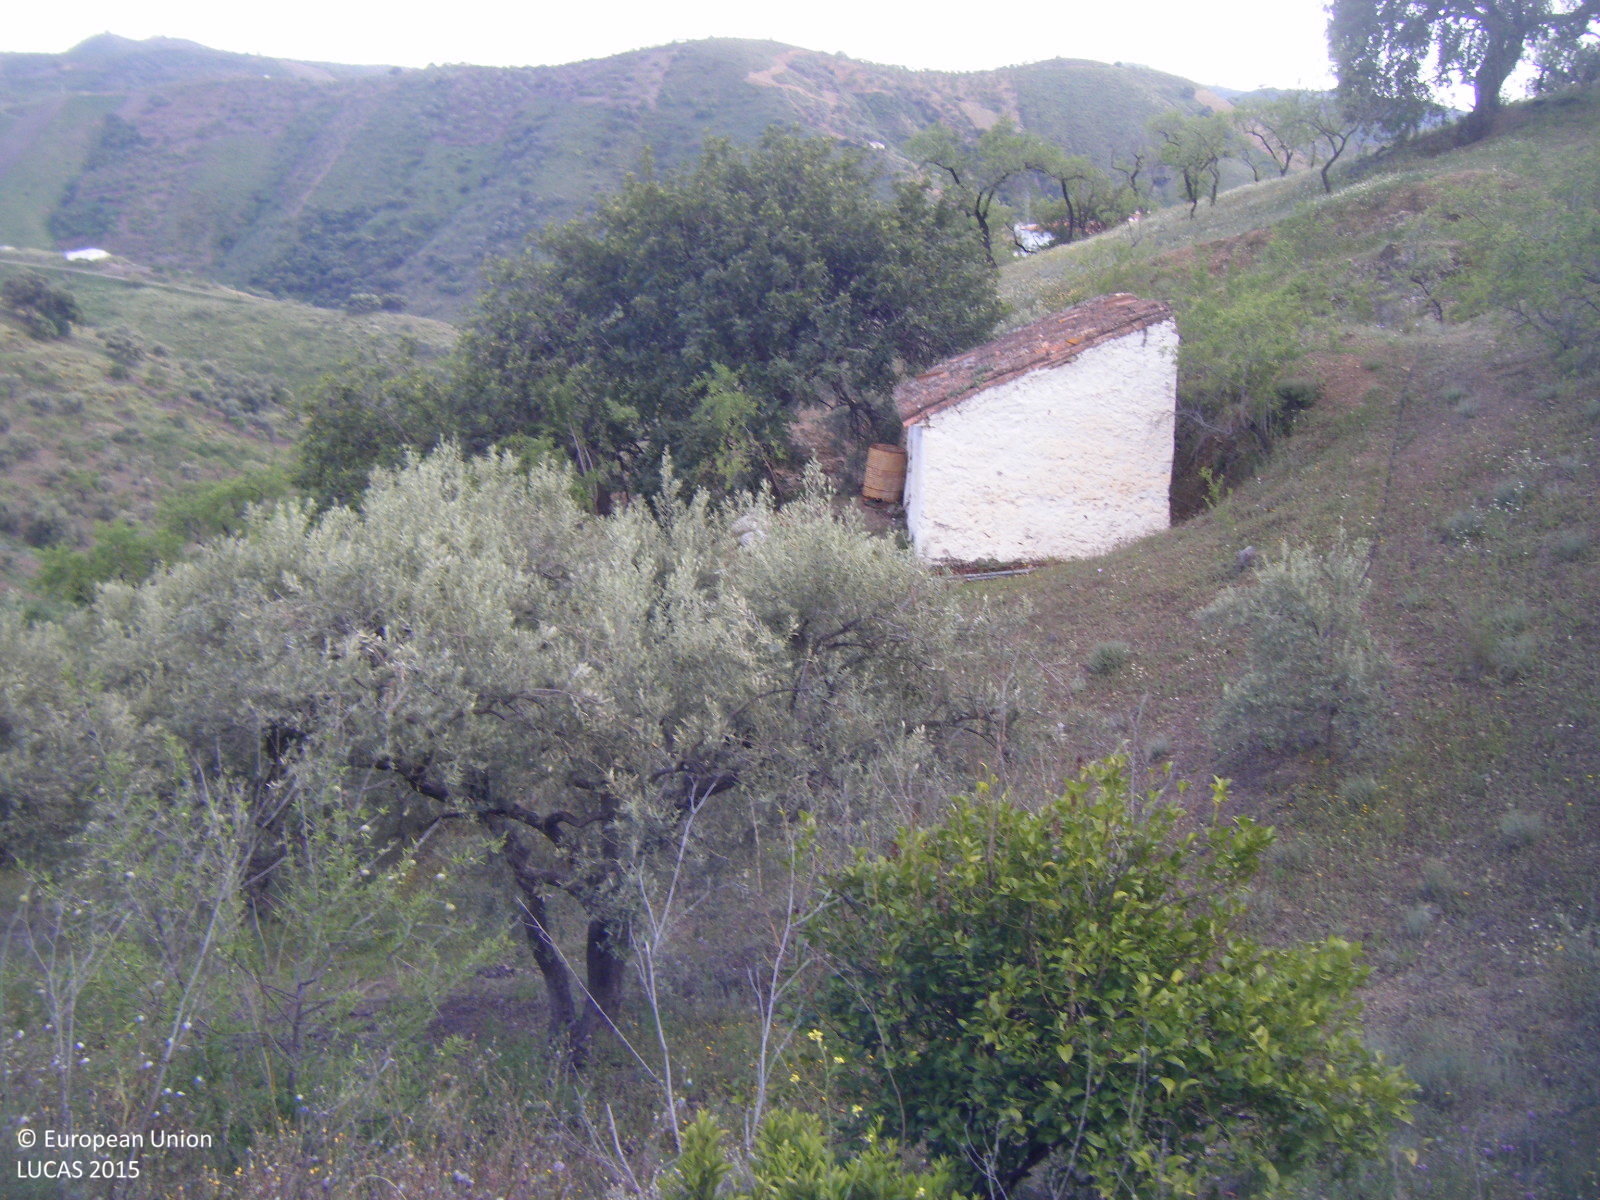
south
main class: Cropland
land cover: Olive groves
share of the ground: 25 - 50 %
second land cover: Nuts trees
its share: 10 - 25 %
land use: Agriculture (excluding fallow land and kitchen gardens)
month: April
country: ES
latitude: 36.8473
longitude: -4.0400
